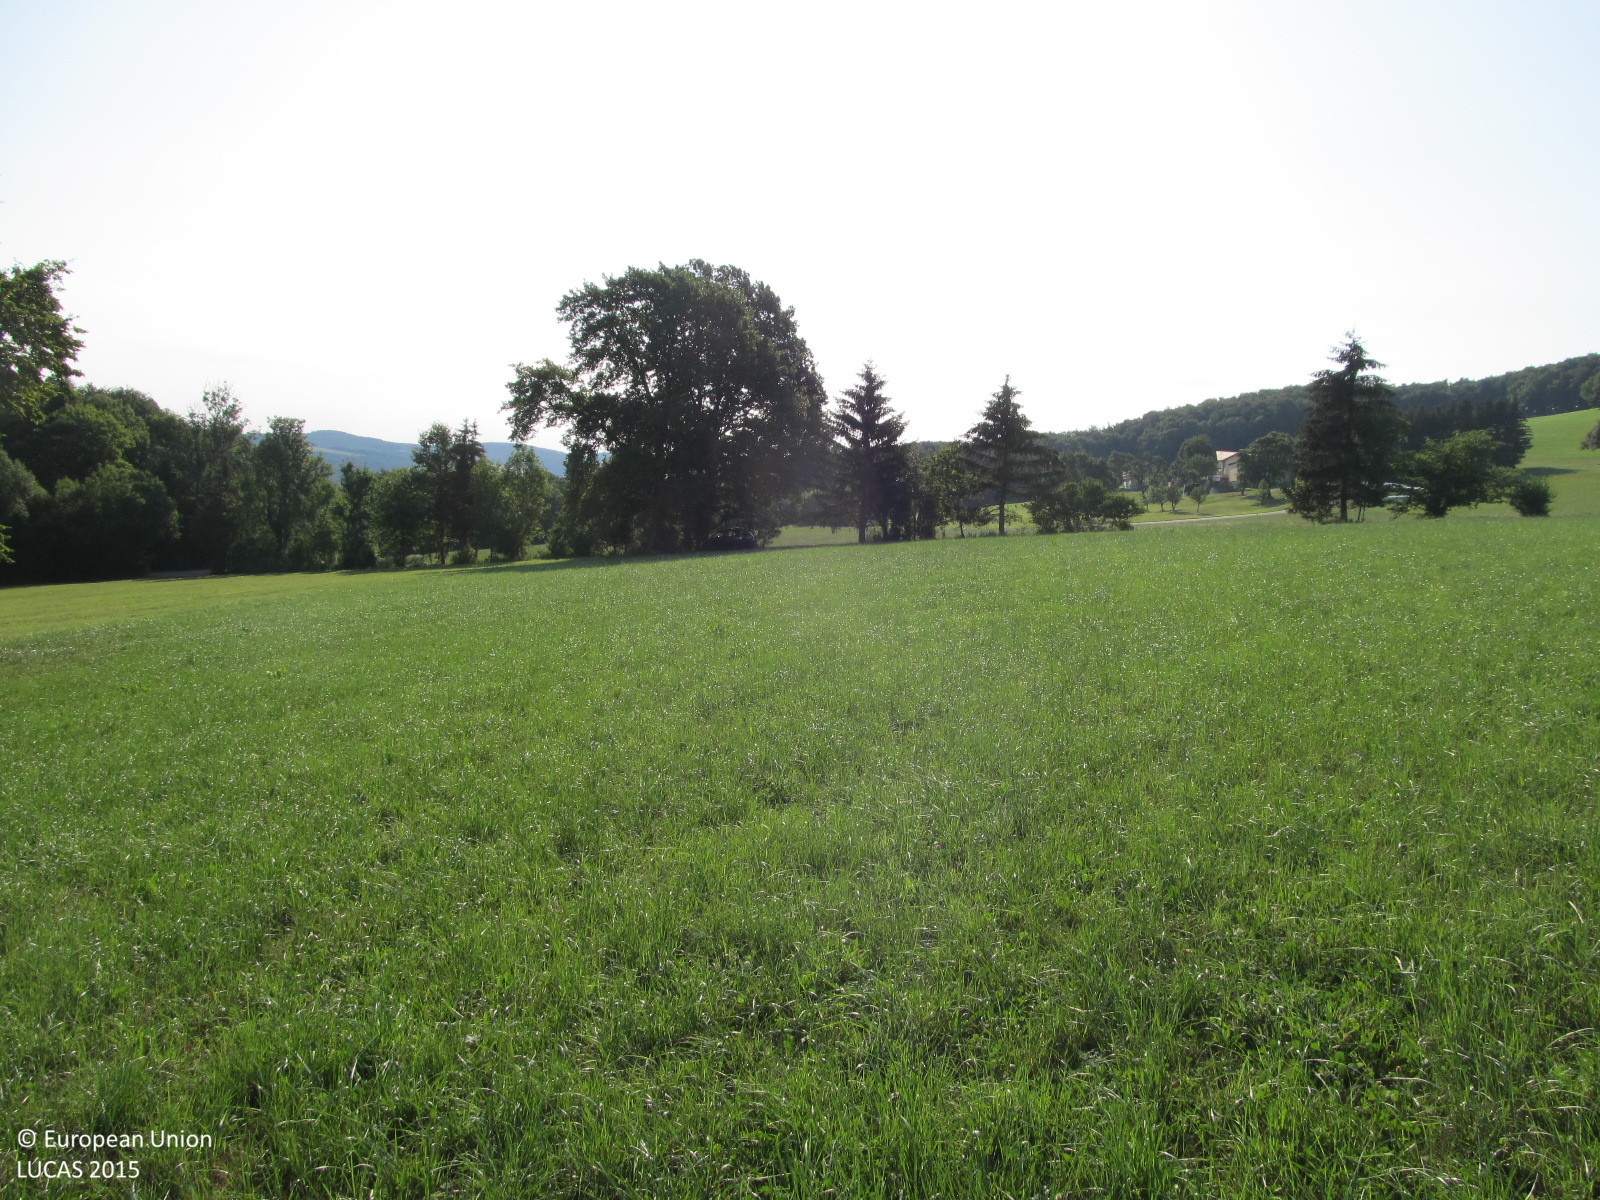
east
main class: Grassland
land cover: Grassland without tree/shrub cover
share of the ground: > 75 %
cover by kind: herbaceous plants 100 %
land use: Agriculture (excluding fallow land and kitchen gardens)
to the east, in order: Grassland without tree/shrub cover; Broadleaved woodland; Paved roads, cycling and walking lanes; Spruce dominated mixed woodland; Ditches and canals; Grassland without tree/shrub cover; Ditches and canals; Paved roads, cycling and walking lanes; Grassland without tree/shrub cover
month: August
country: AT
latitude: 48.1447
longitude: 15.7687
